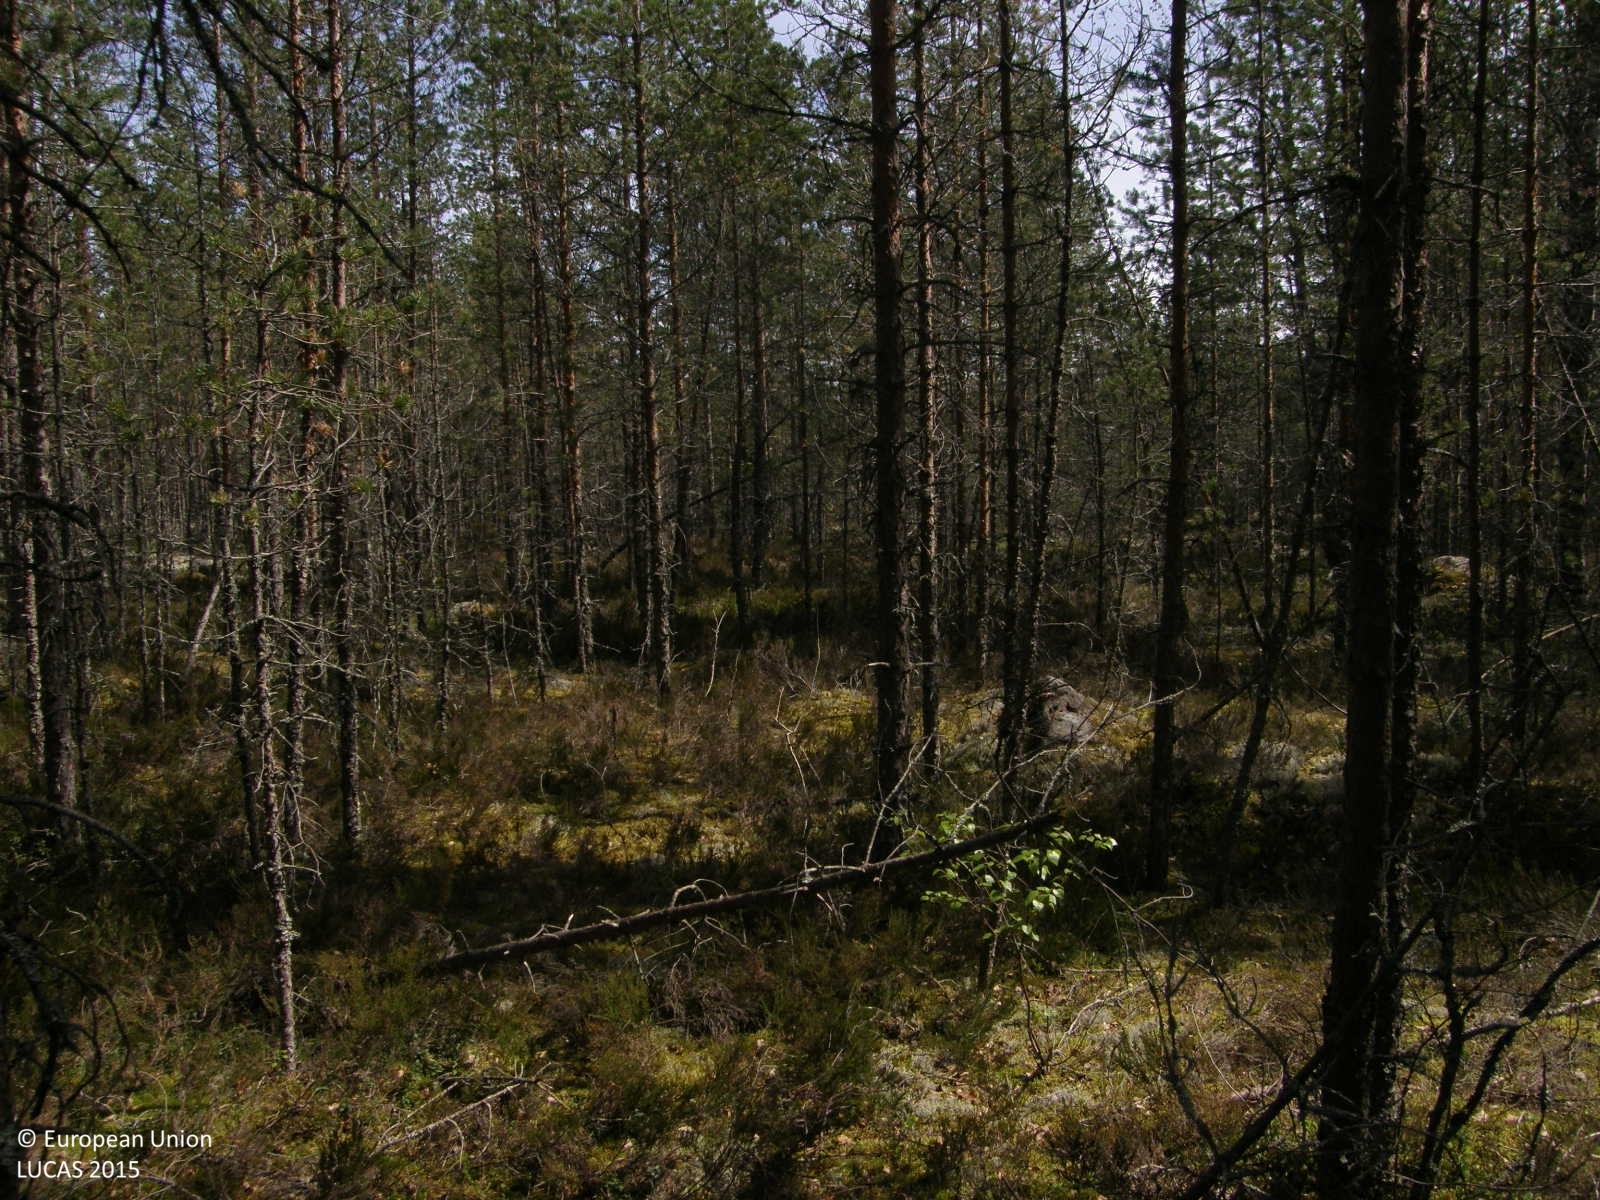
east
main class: Woodland
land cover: Pine dominated coniferous woodland
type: boreal forest
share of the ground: > 75 %
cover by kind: coniferous forest trees 90 %, broadleaved forest trees 5 %, lichens and mosses 5 %
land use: Forestry
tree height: > 5 m
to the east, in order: Pine dominated coniferous woodland
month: June
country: FI
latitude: 62.1382
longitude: 22.3514
